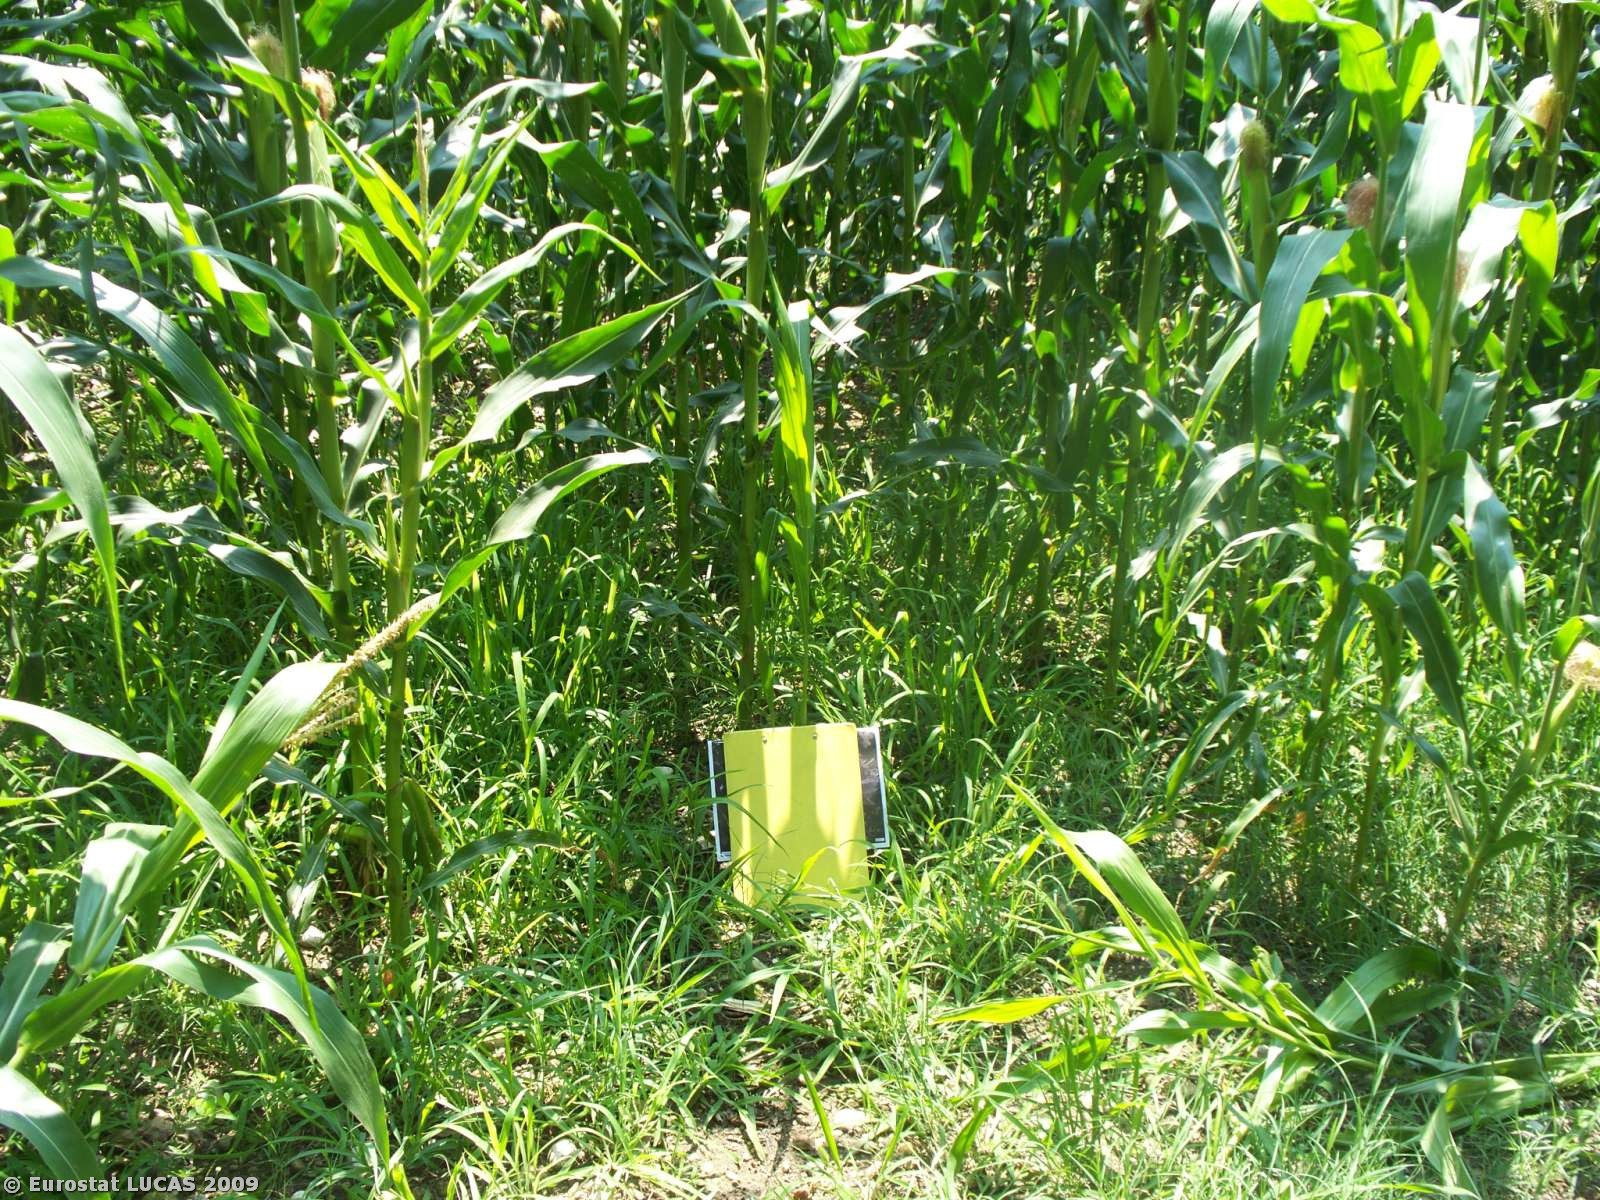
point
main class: Cropland
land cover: Maize
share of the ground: > 75 %
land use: Agriculture (excluding fallow land and kitchen gardens)
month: July
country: IT
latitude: 45.8910
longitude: 12.4324
